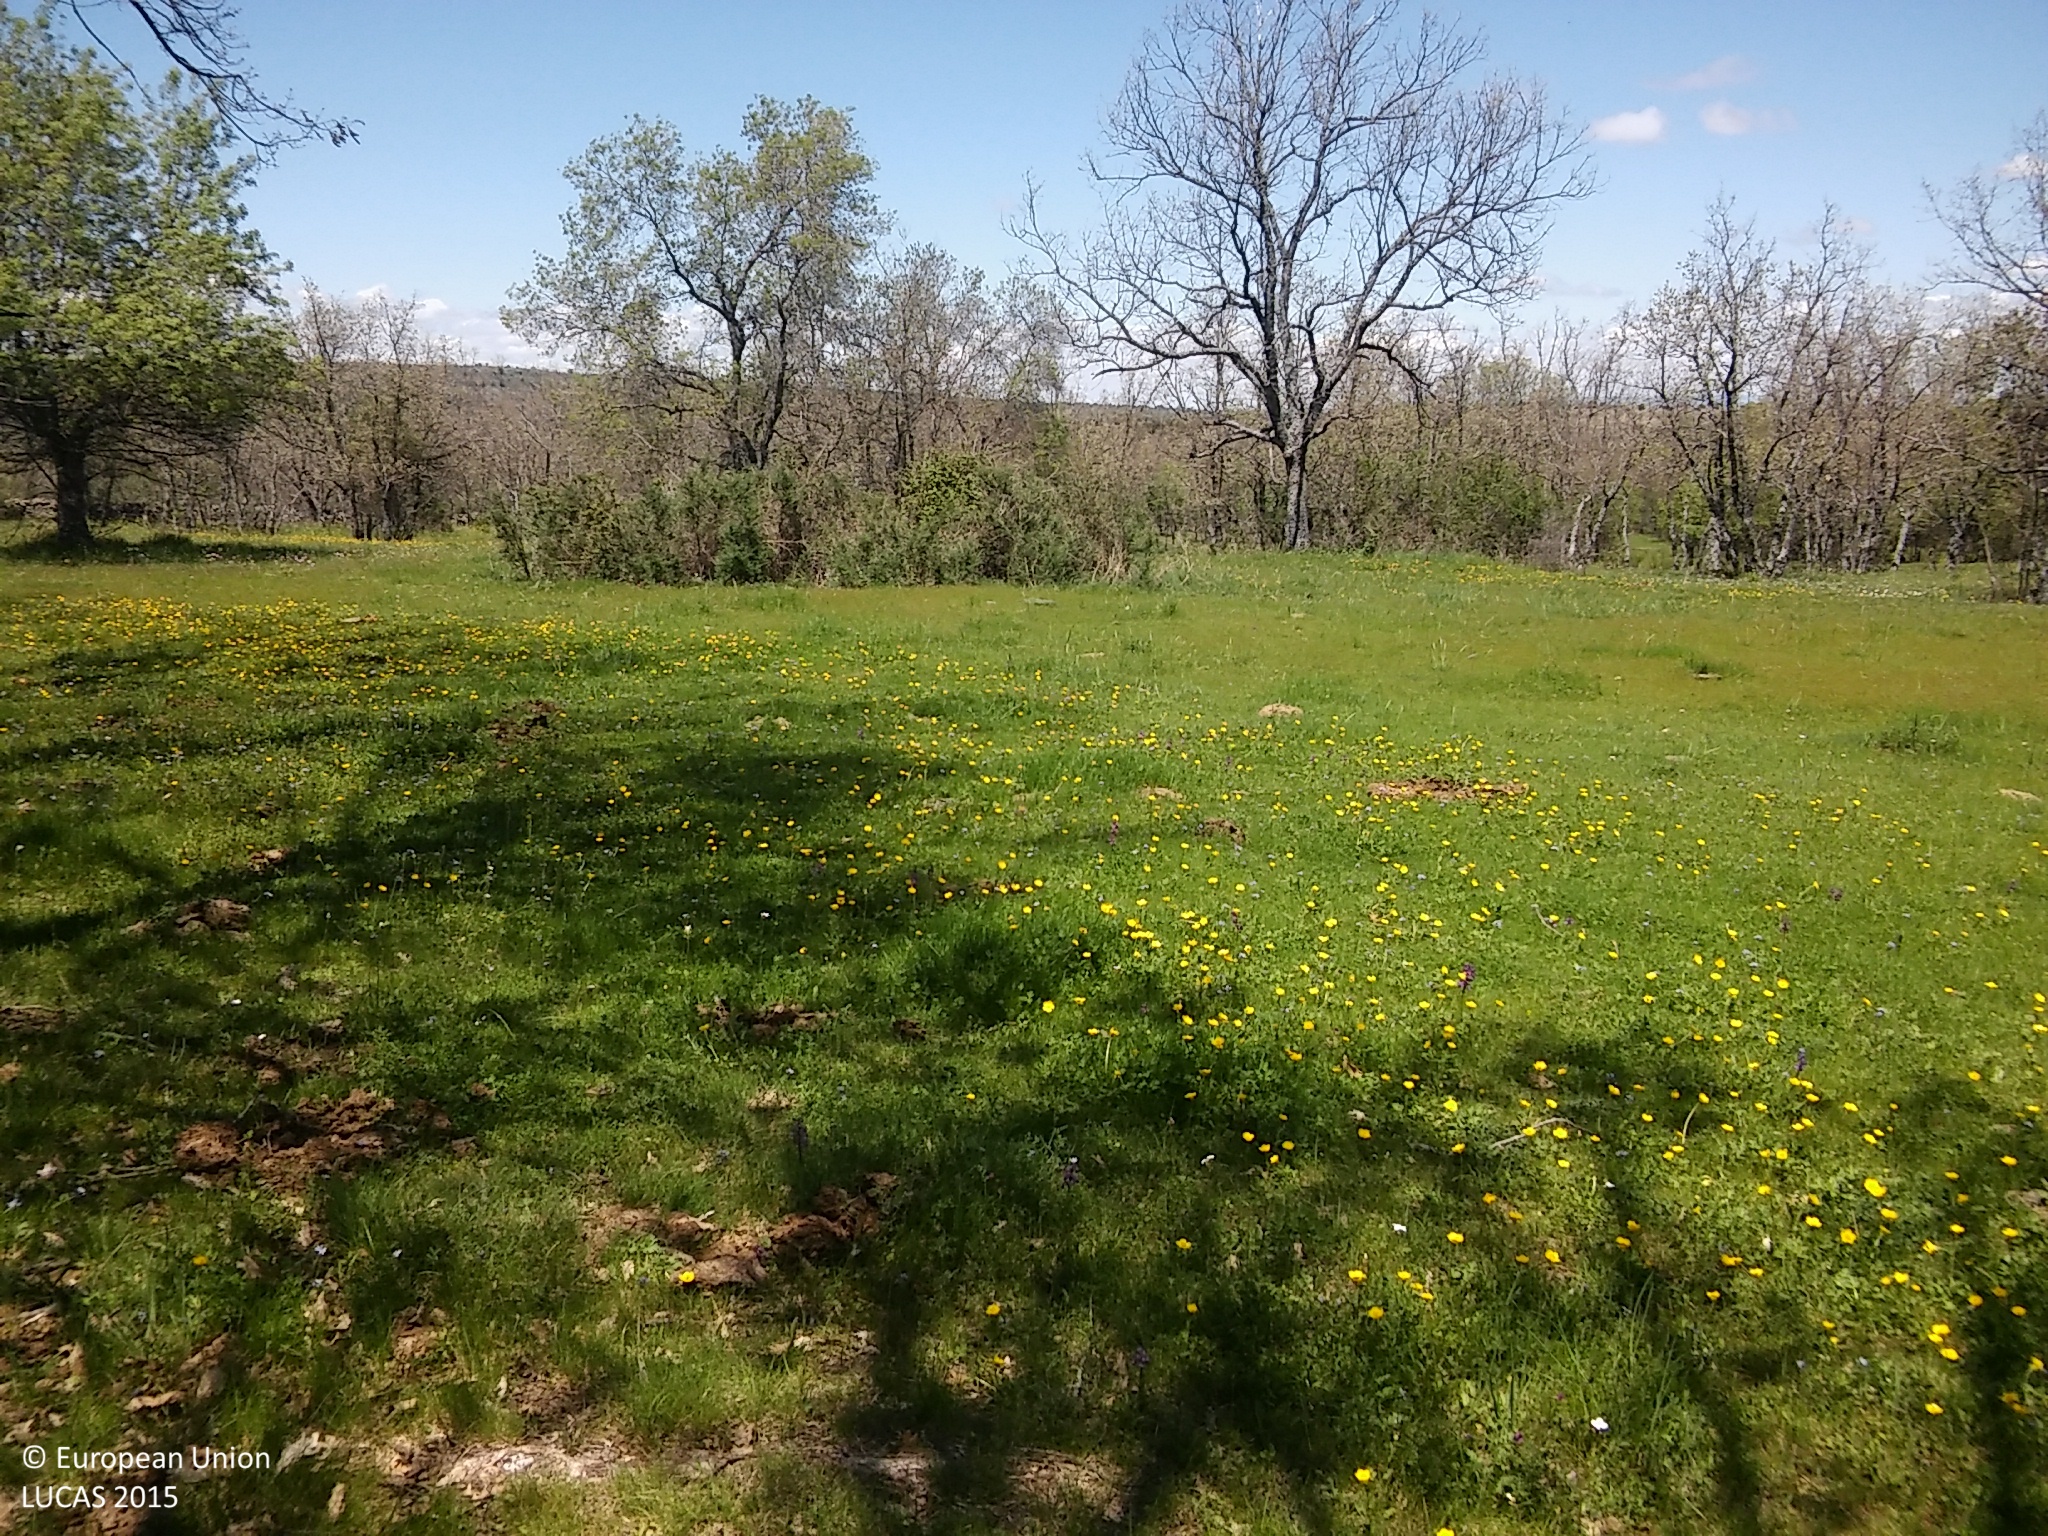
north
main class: Woodland
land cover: Broadleaved woodland
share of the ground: 25 - 50 %
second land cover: Grassland without tree/shrub cover
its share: > 75 %
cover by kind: herbaceous plants 50 %, broadleaved forest trees 45 %, shrubs 5 %
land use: Forestry
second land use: Agriculture (excluding fallow land and kitchen gardens)
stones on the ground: 10 - 25 %
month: May
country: ES
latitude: 41.0695
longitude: -3.8893
